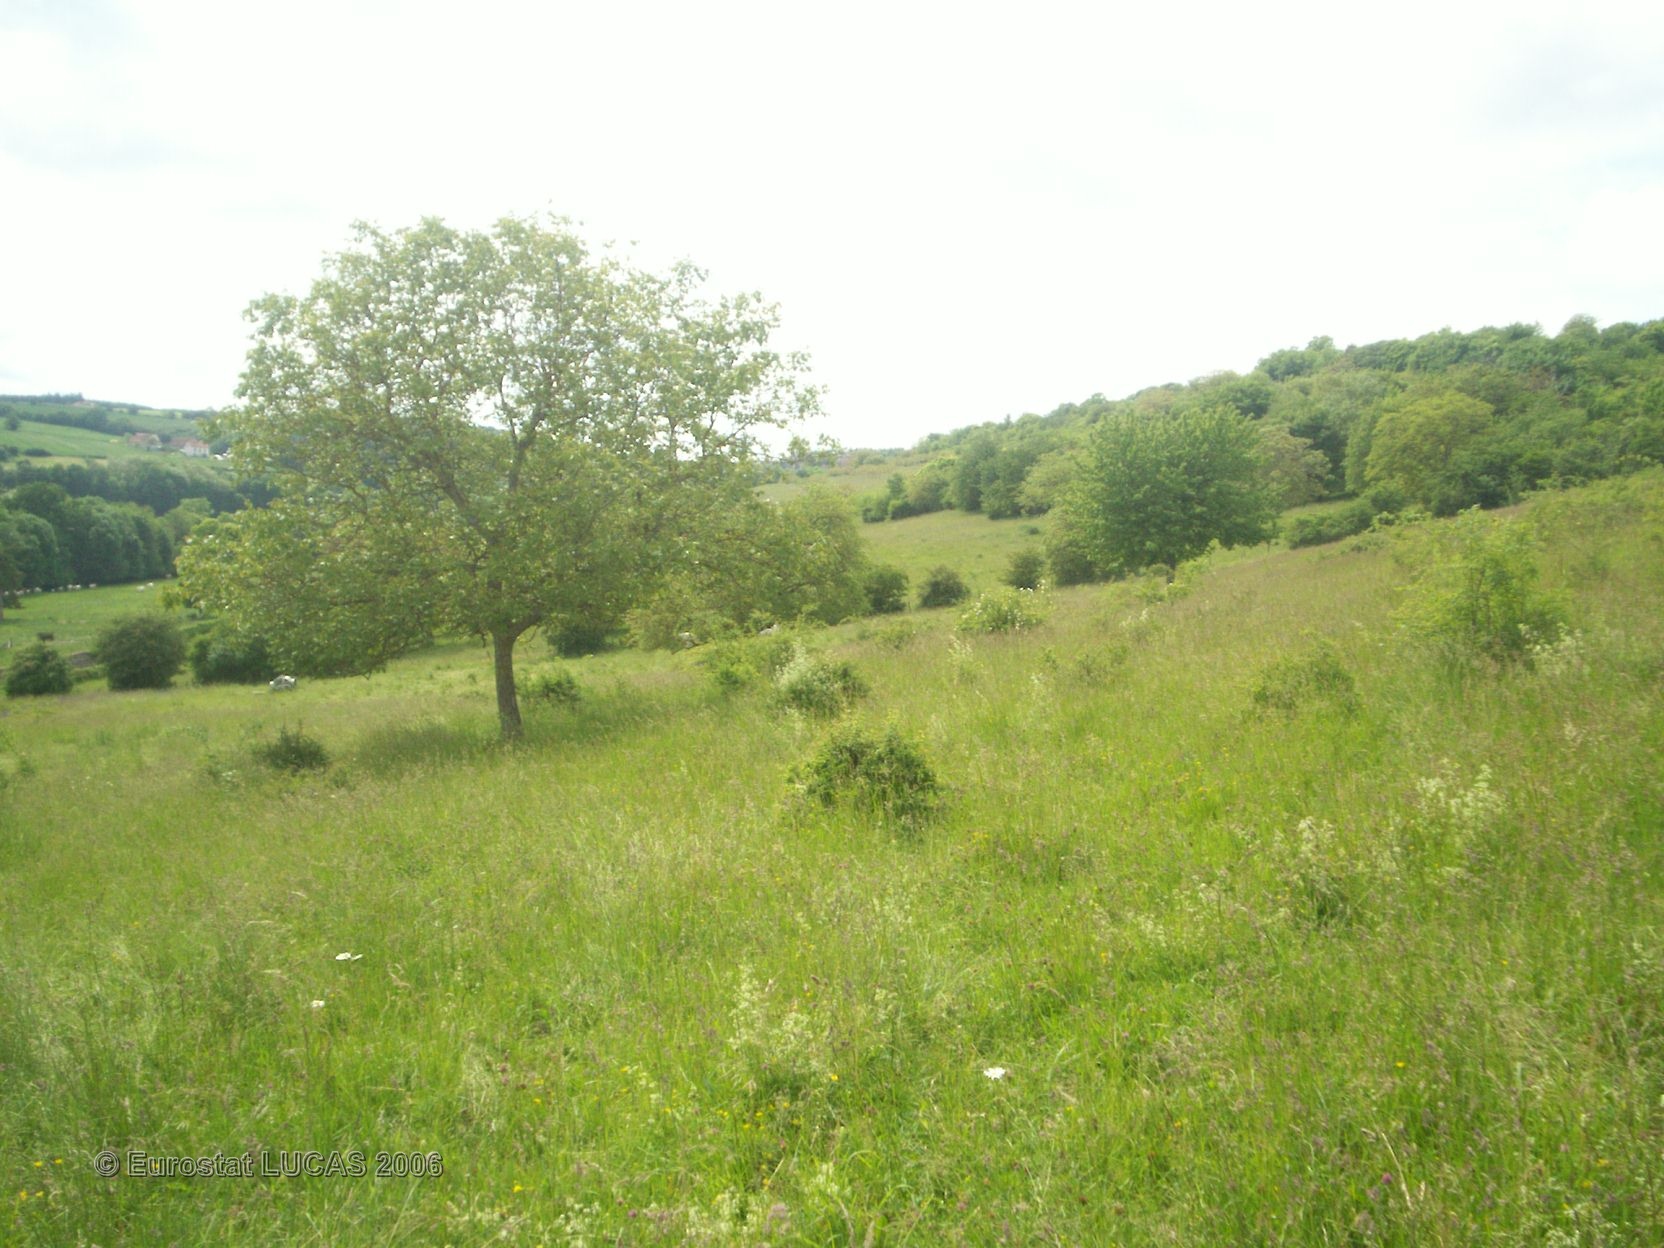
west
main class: Grassland
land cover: Grassland with sparse tree/shrub cover
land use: Agriculture (excluding fallow land and kitchen gardens)
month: May
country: FR
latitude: 46.1625
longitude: 3.0700
